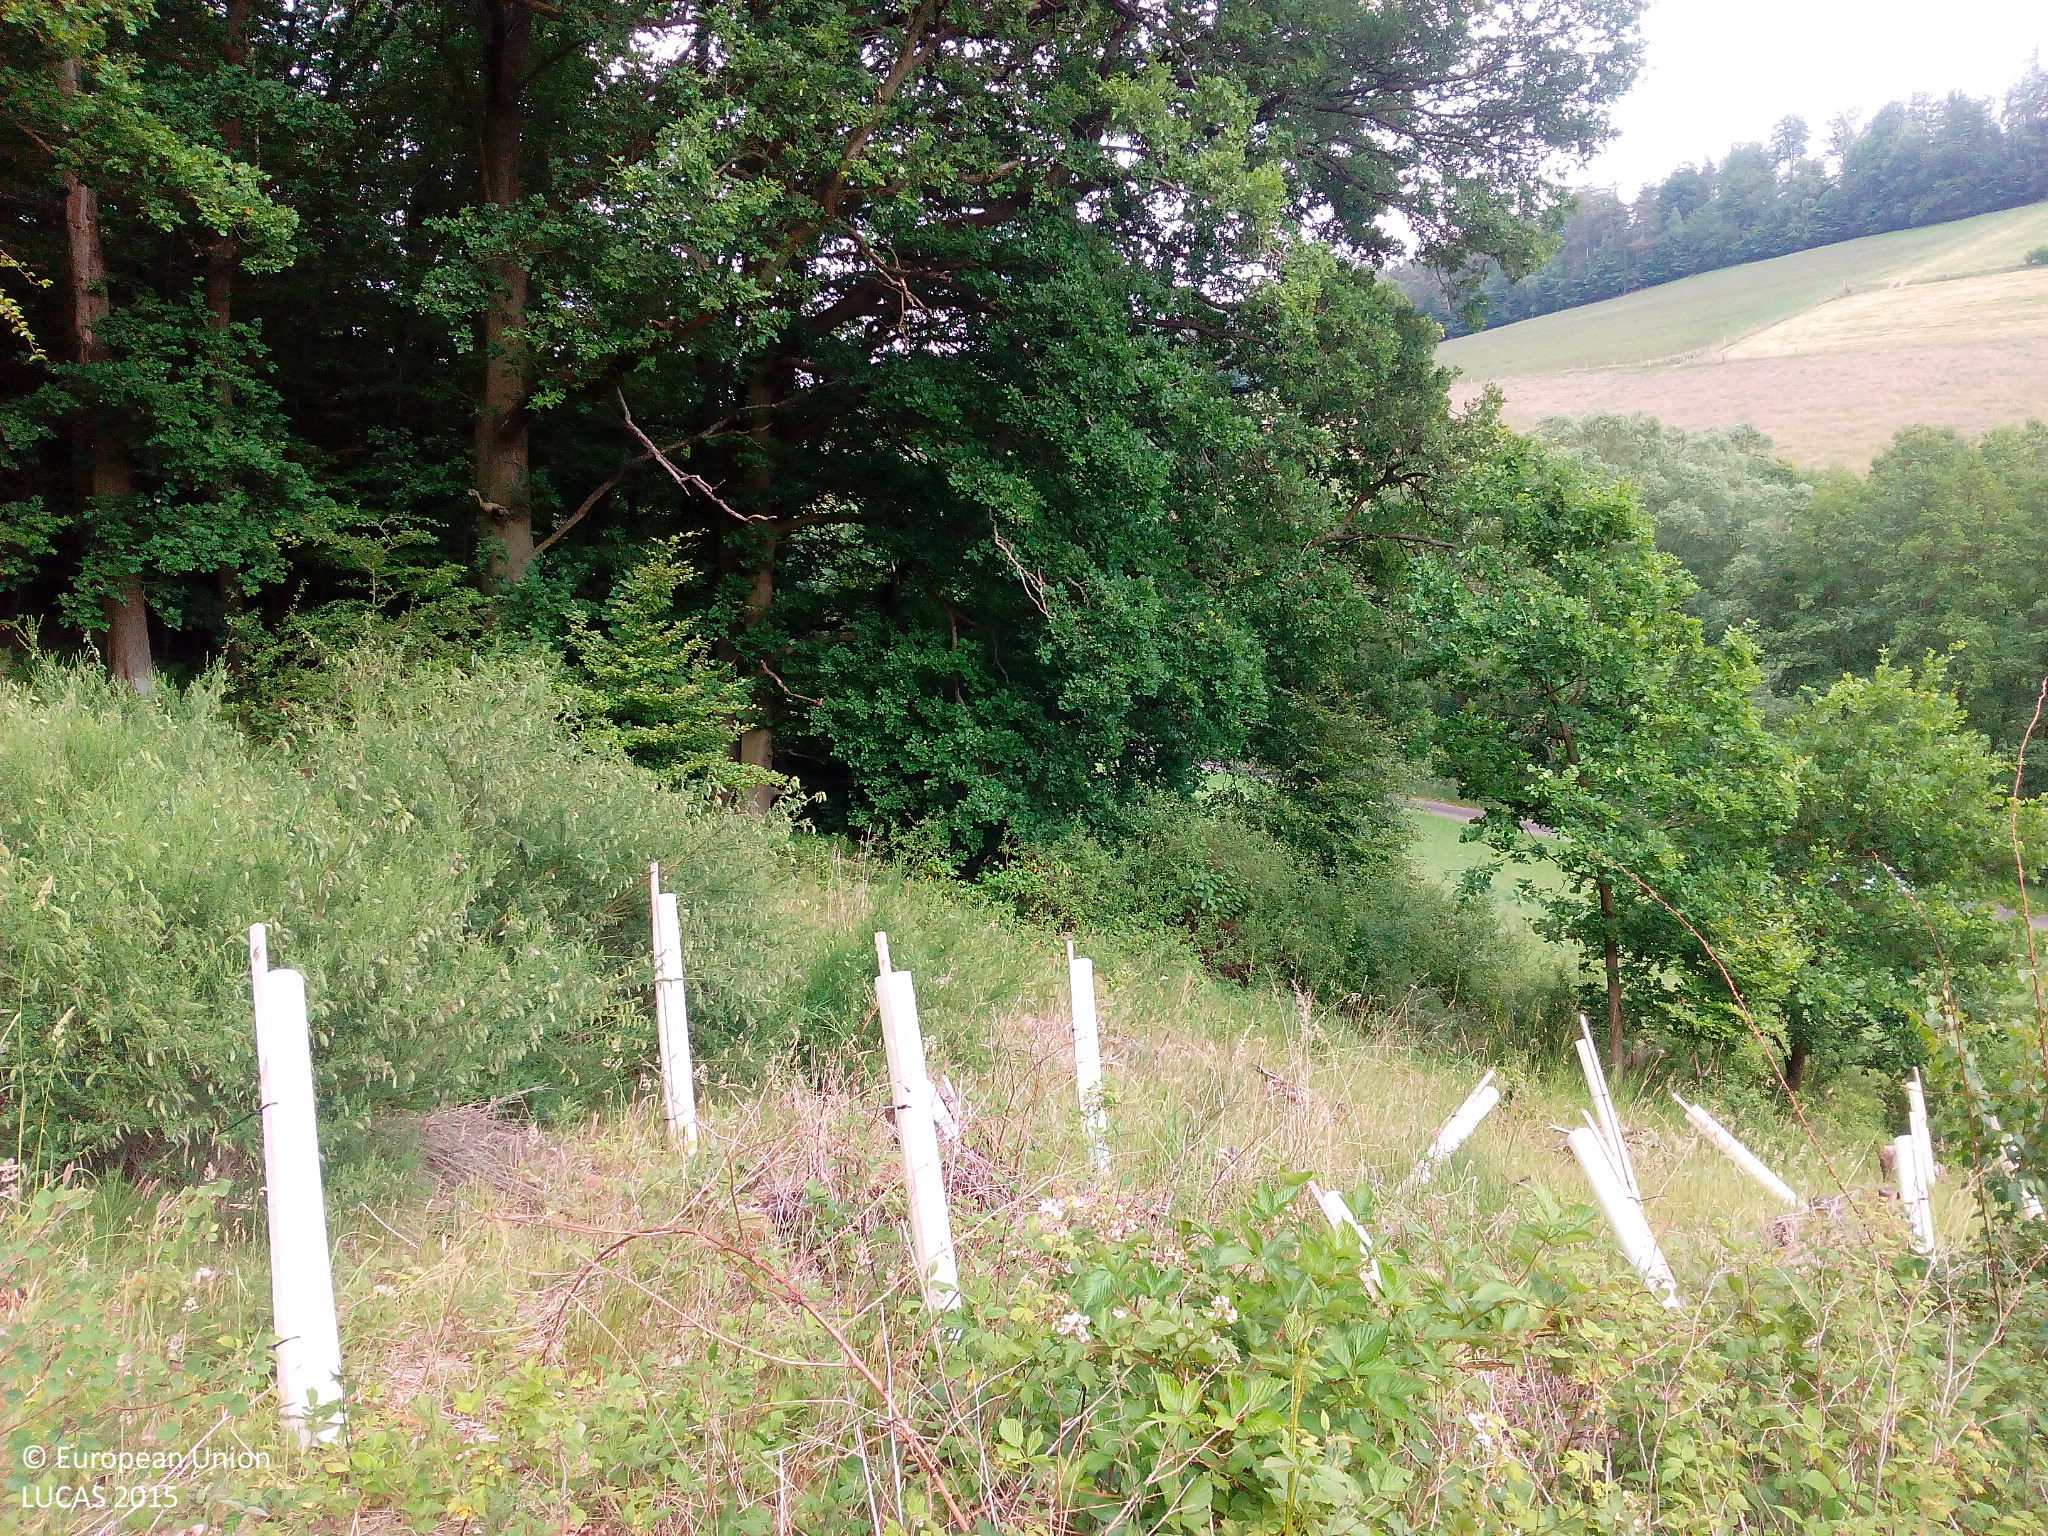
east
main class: Shrubland
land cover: Shrubland with sparse tree cover
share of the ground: > 75 %
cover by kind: herbaceous plants 55 %, shrubs 40 %, broadleaved forest trees 5 %
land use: Forestry
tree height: < 5 m
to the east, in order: Shrubland with sparse tree cover; Broadleaved woodland; Grassland without tree/shrub cover; Abandoned hedges; Grass margins; Paved roads, cycling and walking lanes; Grass margins; Broadleaved woodland; Temporary grasslands
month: June
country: DE
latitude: 51.0647
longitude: 9.6434
